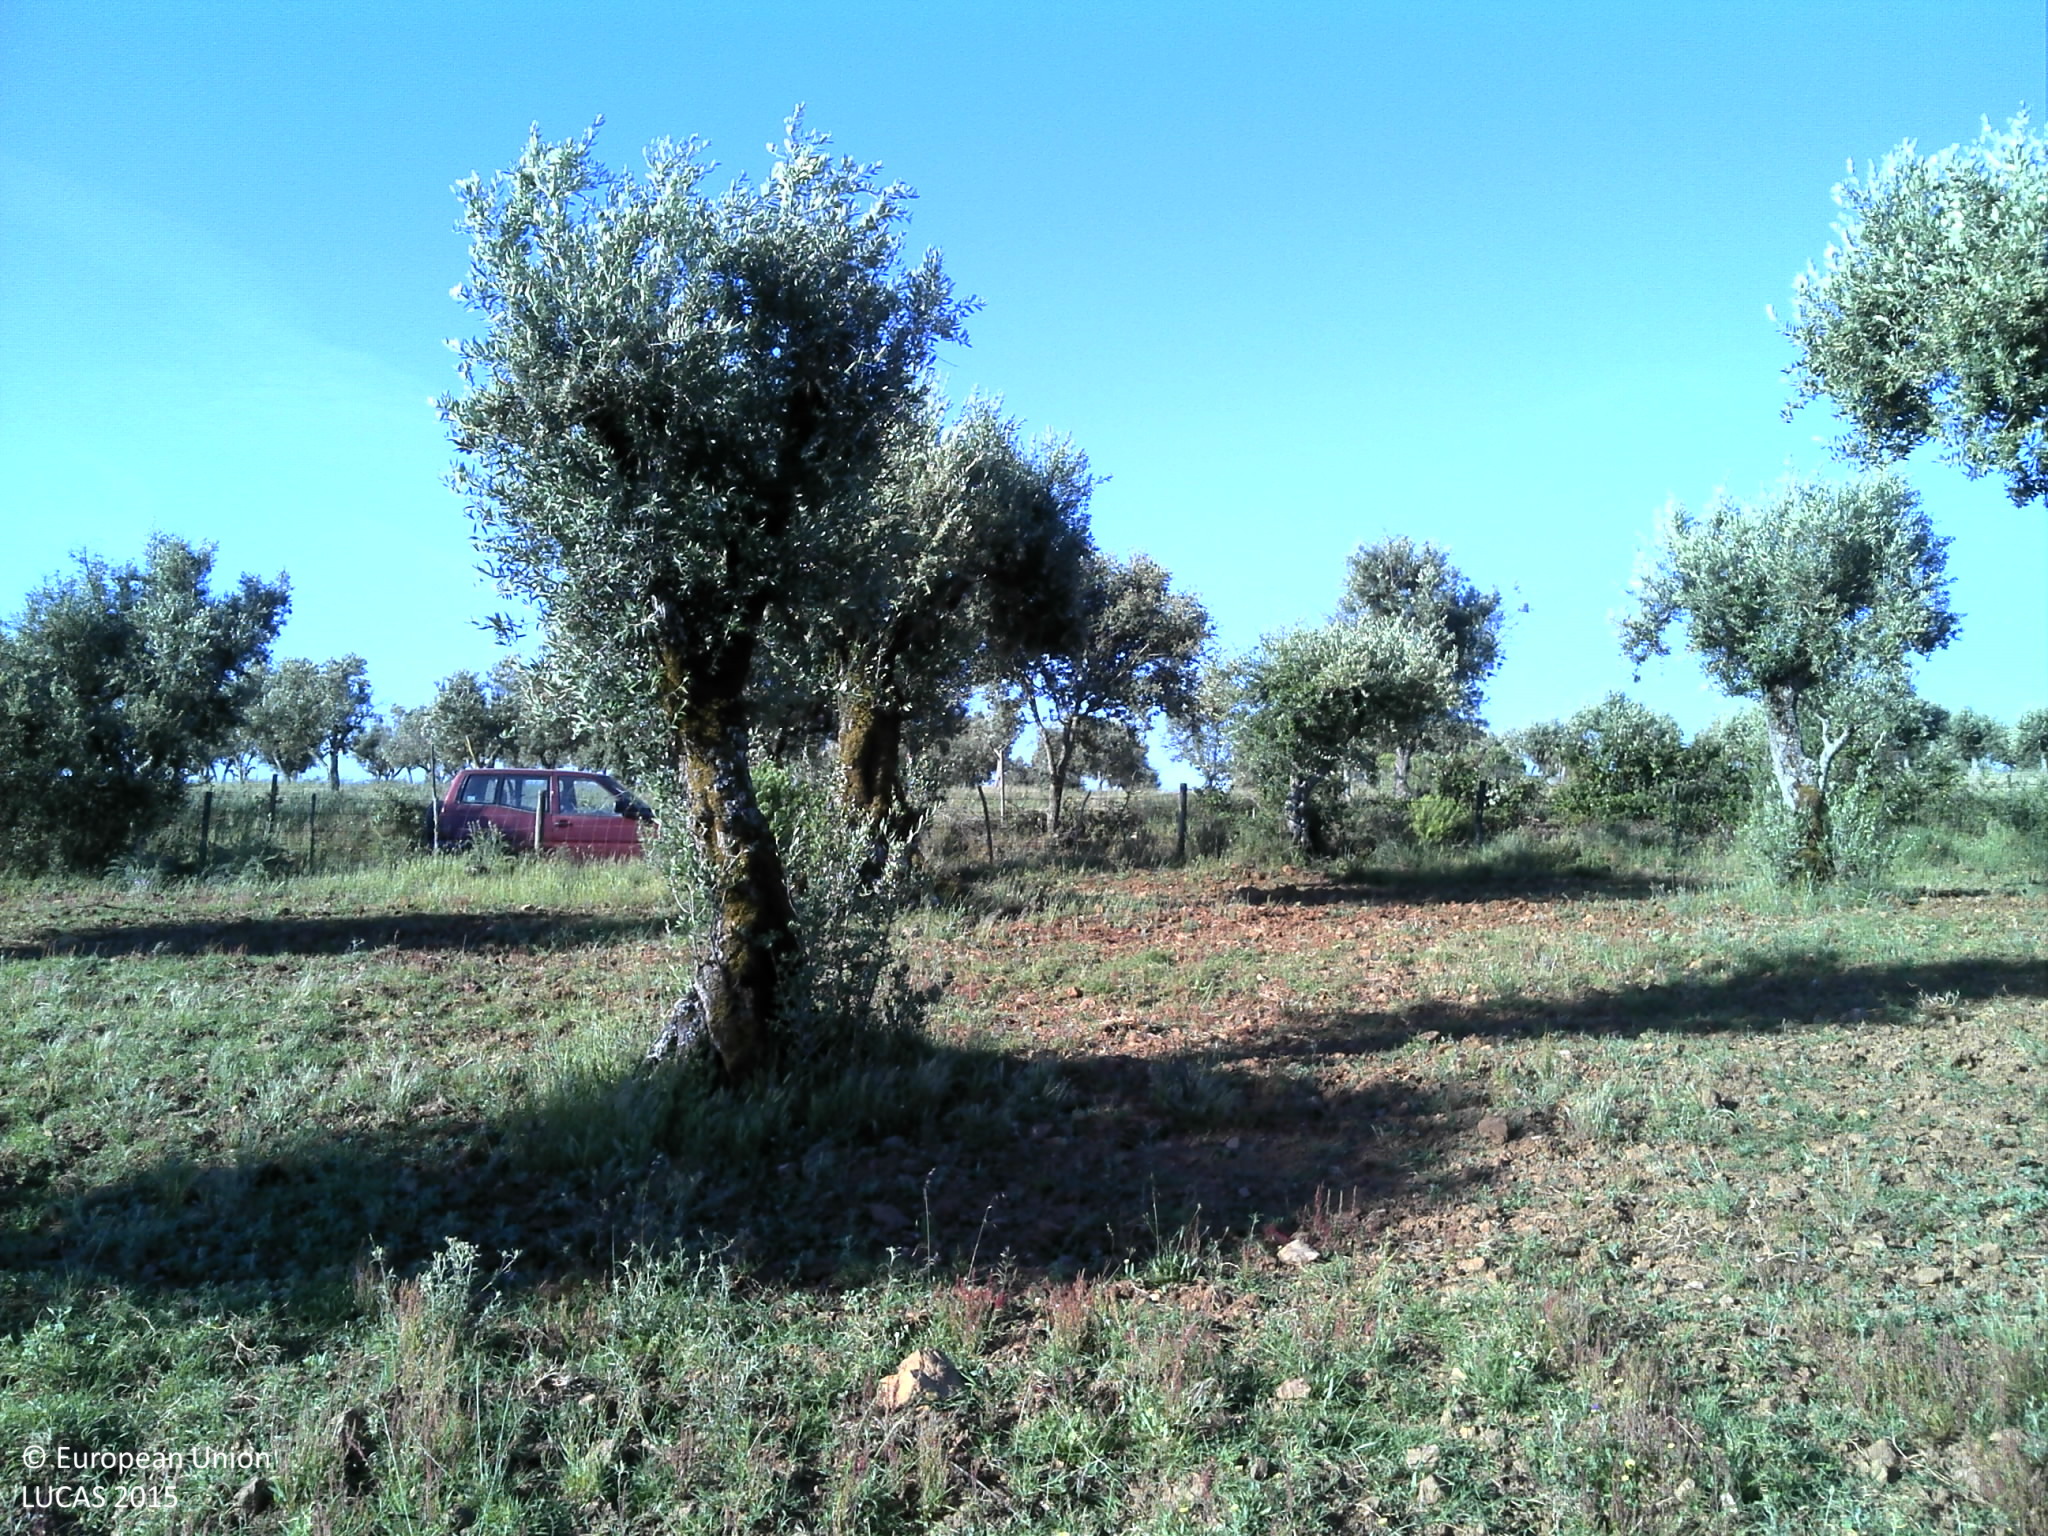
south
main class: Cropland
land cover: Olive groves
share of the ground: 10 - 25 %
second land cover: Grassland without tree/shrub cover
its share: 10 - 25 %
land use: Agriculture (excluding fallow land and kitchen gardens)
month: May
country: PT
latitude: 39.1638
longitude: -7.9797
